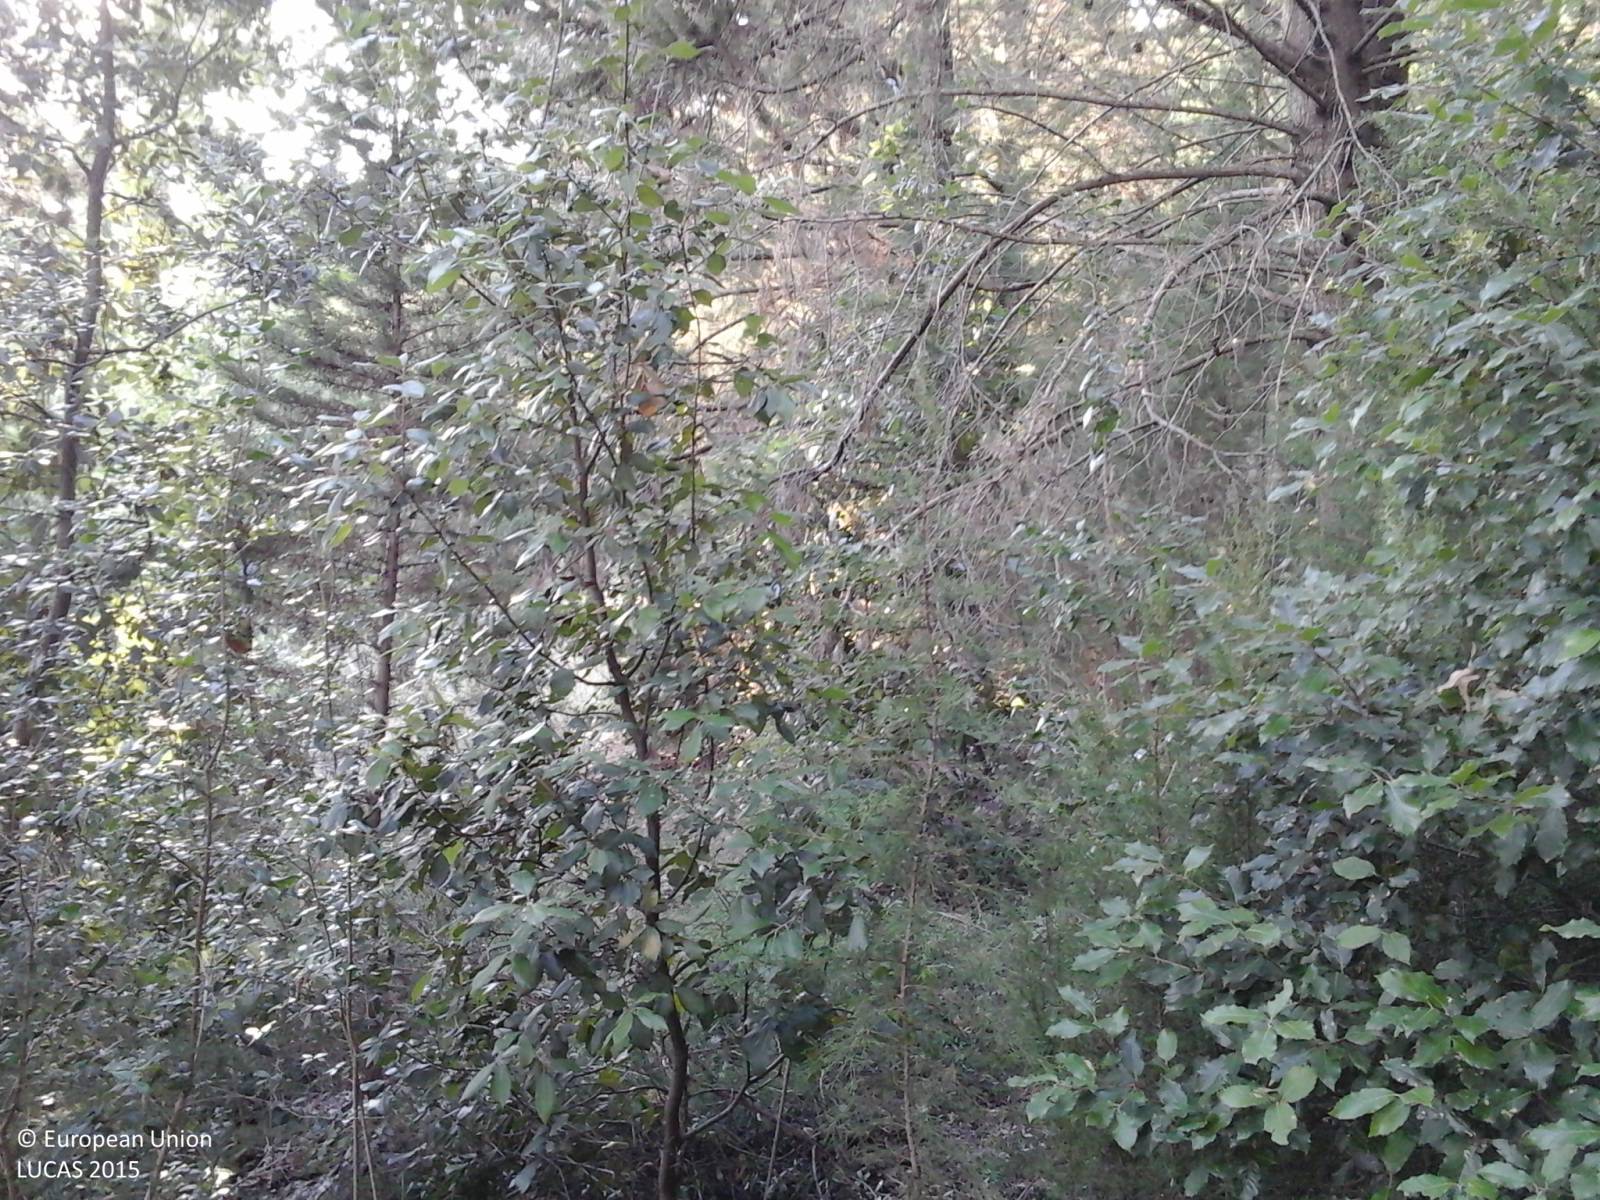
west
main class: Woodland
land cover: Other coniferous woodland
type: coniferous forest of the mediterranean region
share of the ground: > 75 %
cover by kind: coniferous forest trees 90 %, broadleaved forest trees 5 %, herbaceous plants 5 %
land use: Forestry
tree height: > 5 m
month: September
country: IT
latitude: 42.8859
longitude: 12.0629
